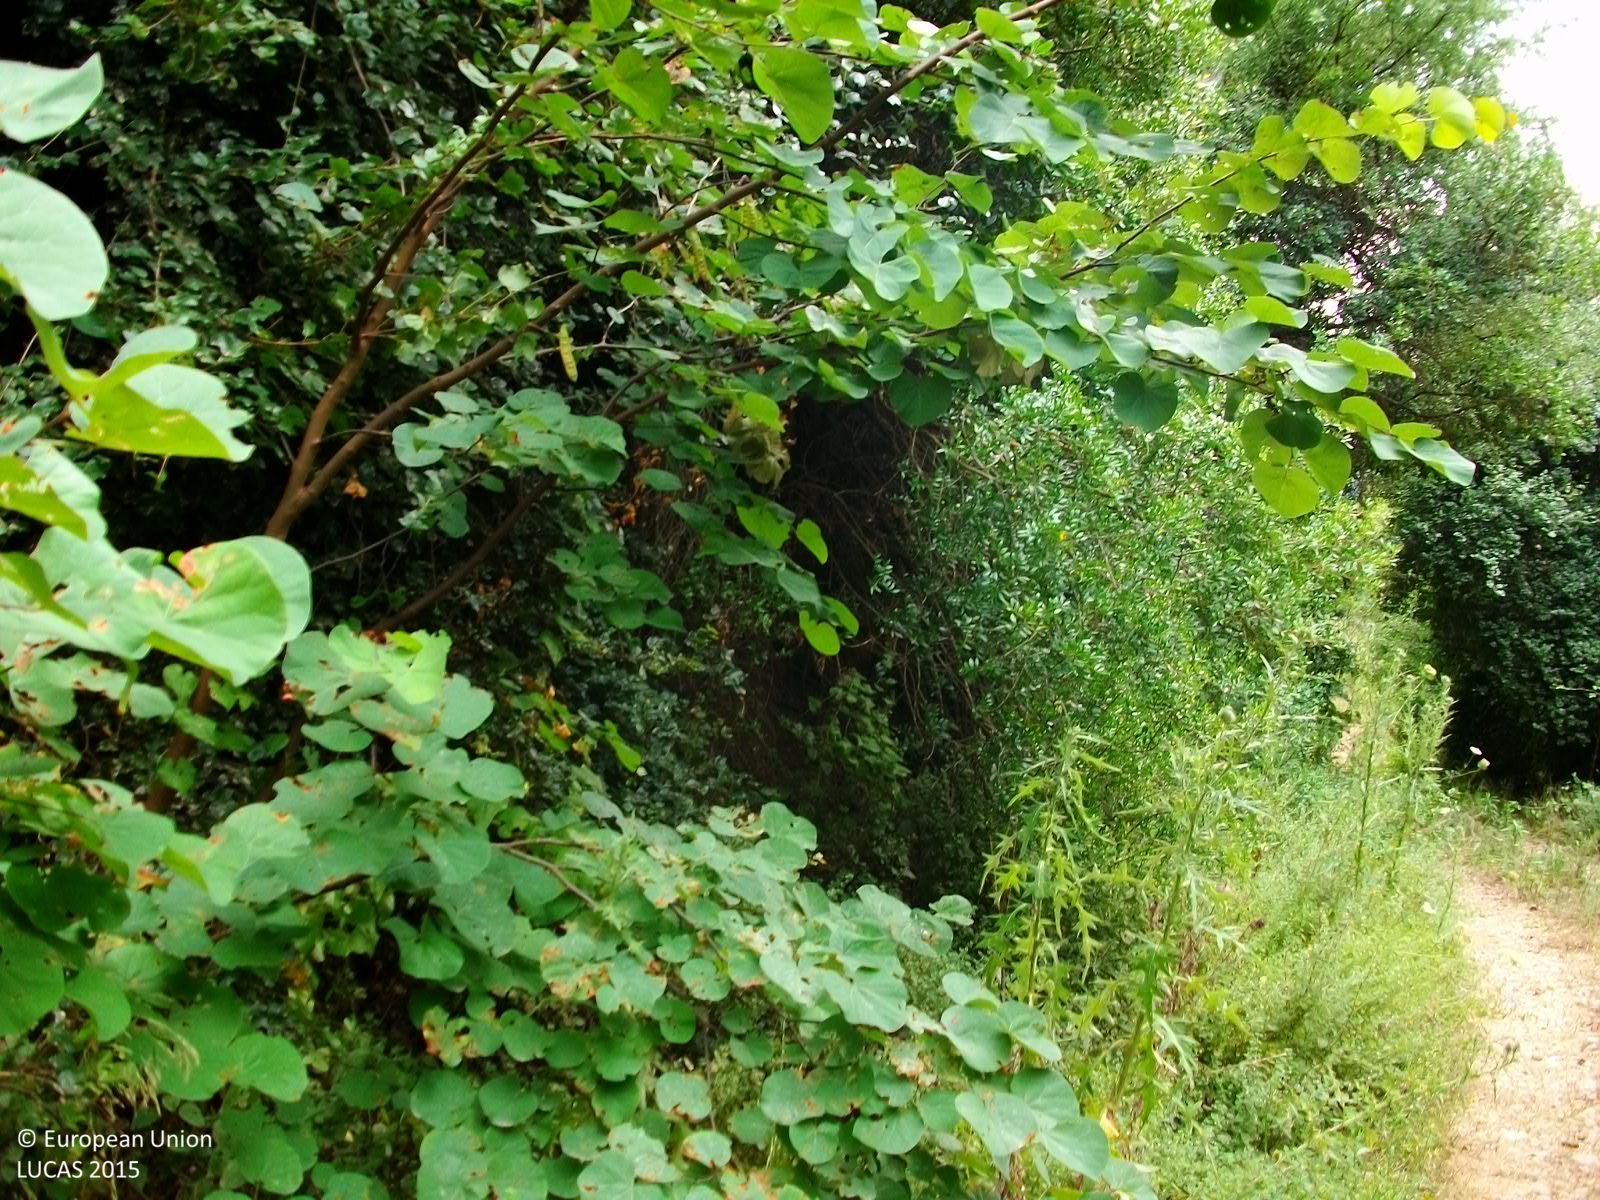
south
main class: Woodland
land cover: Broadleaved woodland
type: broadleaved evergreen forest
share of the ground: > 75 %
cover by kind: broadleaved forest trees 95 %, shrubs 5 %
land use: Semi-natural and natural areas not in use
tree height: > 5 m
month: July
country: GR
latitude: 37.0007
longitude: 21.8744
